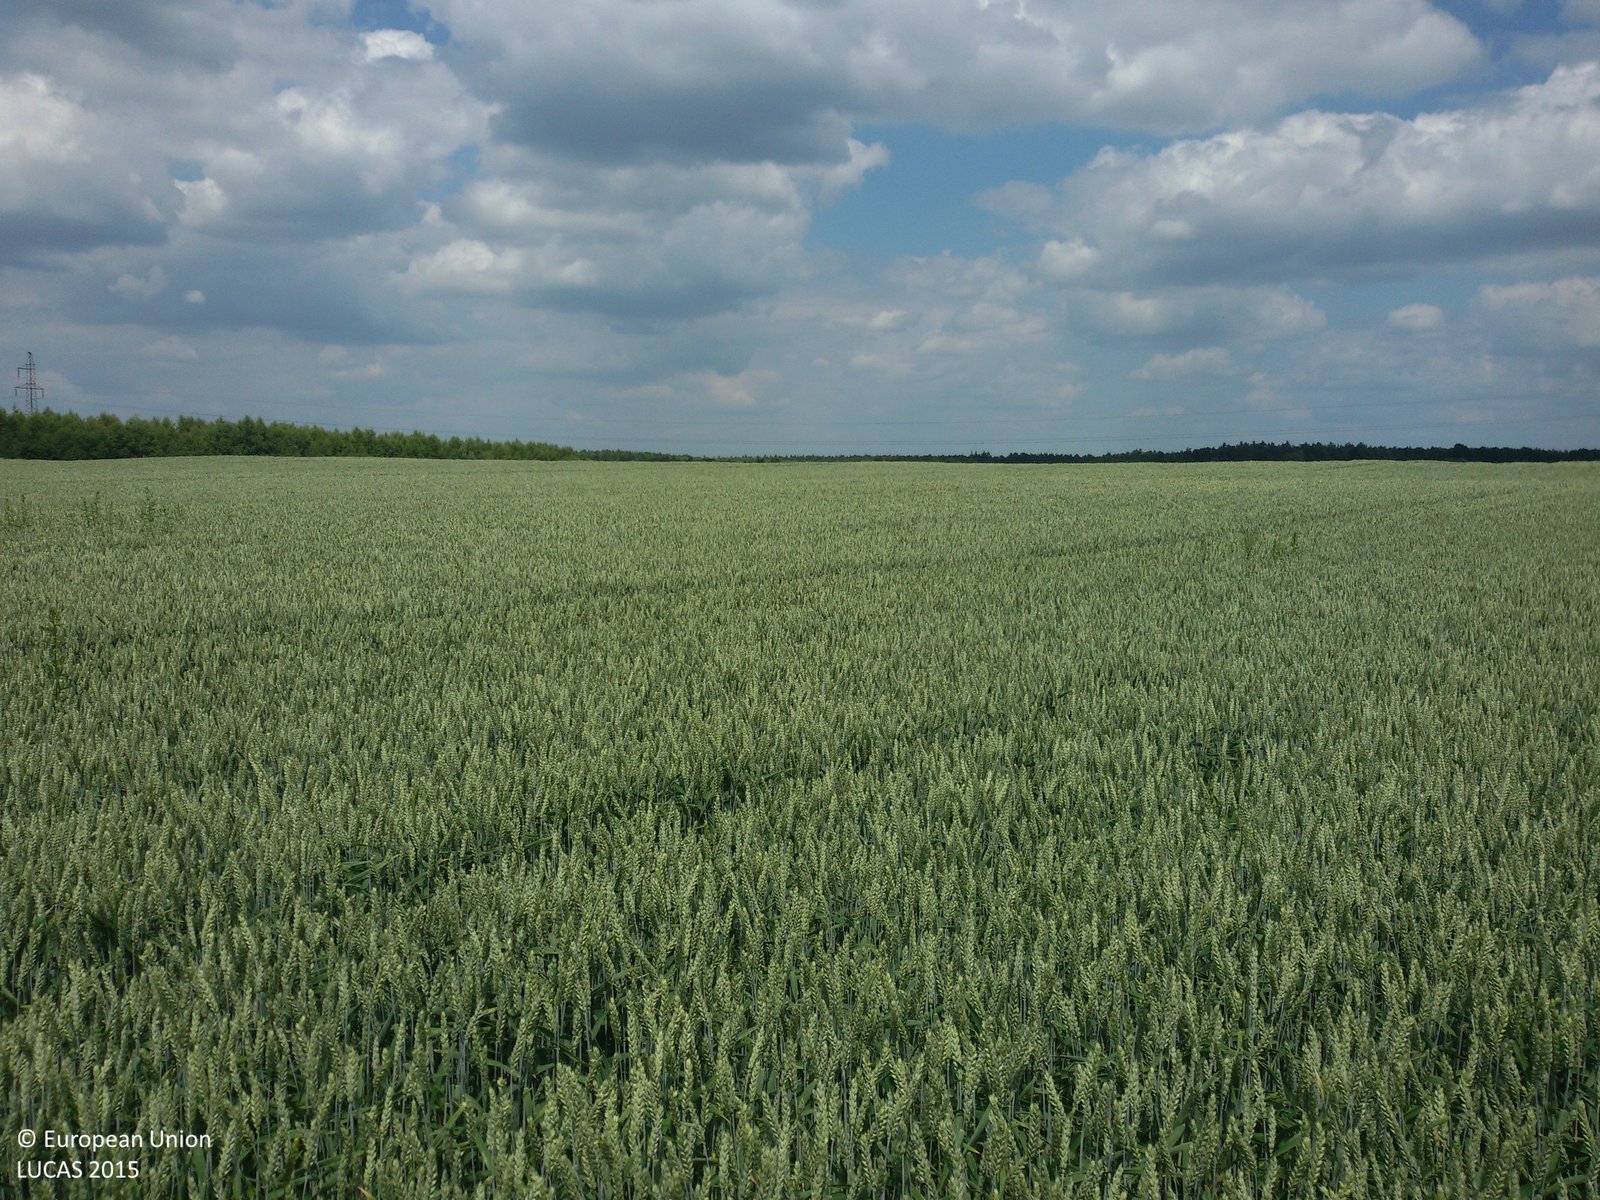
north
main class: Cropland
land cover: Common wheat
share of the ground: > 75 %
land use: Agriculture (excluding fallow land and kitchen gardens)
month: June
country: PL
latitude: 50.8677
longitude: 21.7199
